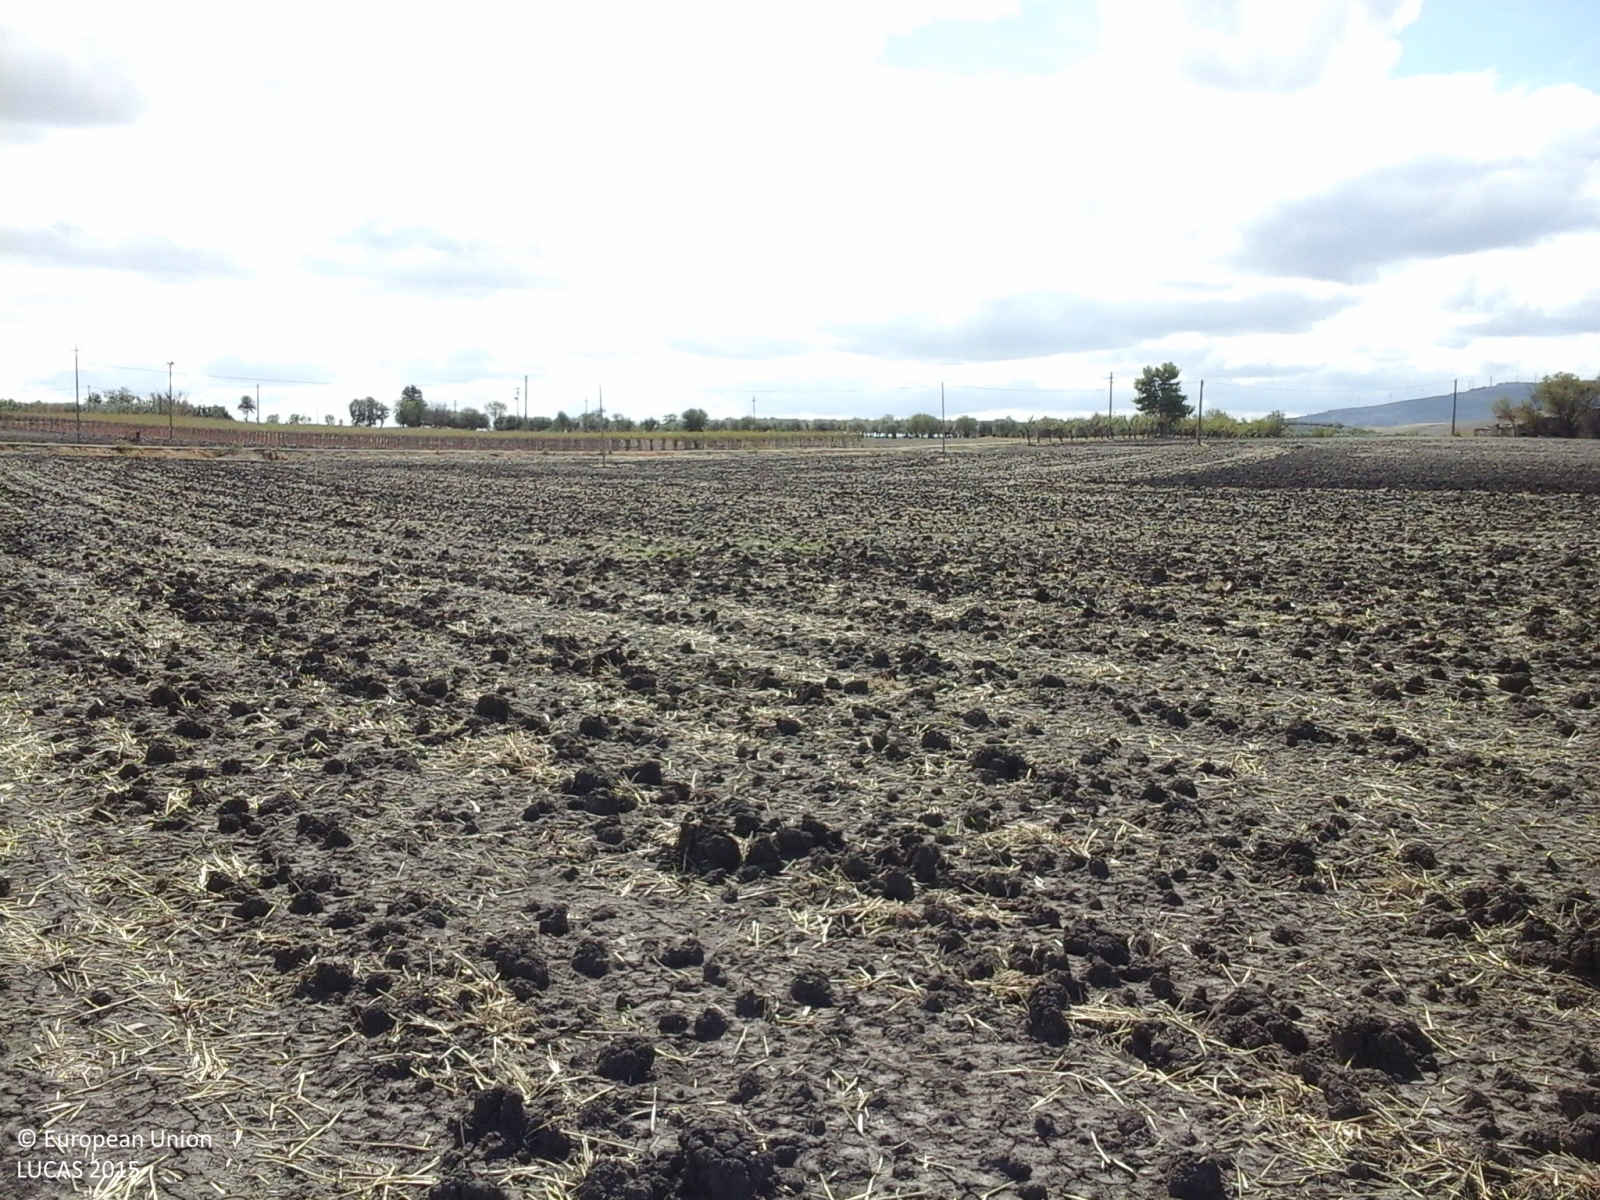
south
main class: Cropland
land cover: Durum wheat
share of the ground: > 75 %
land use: Agriculture (excluding fallow land and kitchen gardens)
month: September
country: IT
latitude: 41.6357
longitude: 15.1571
